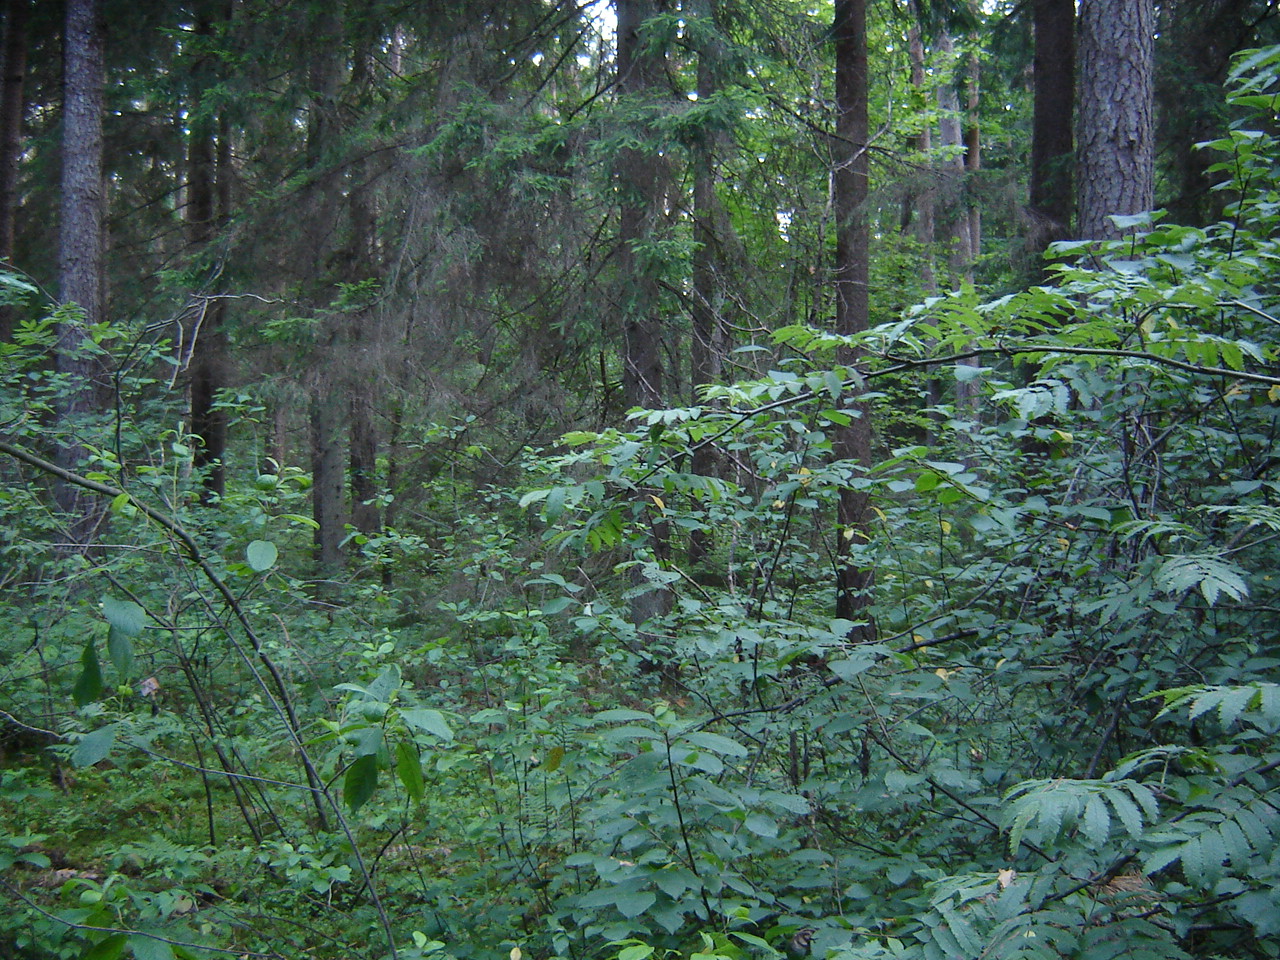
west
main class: Woodland
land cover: Pine dominated coniferous woodland
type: hemiboreal forest and nemoral coniferous forest and mixed broadleaved-coniferous forest
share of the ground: > 75 %
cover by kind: coniferous forest trees 80 %, broadleaved forest trees 10 %, herbaceous plants 5 %, lichens and mosses 5 %
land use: Forestry
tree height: > 5 m
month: July
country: LT
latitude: 55.5093
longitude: 25.0772
